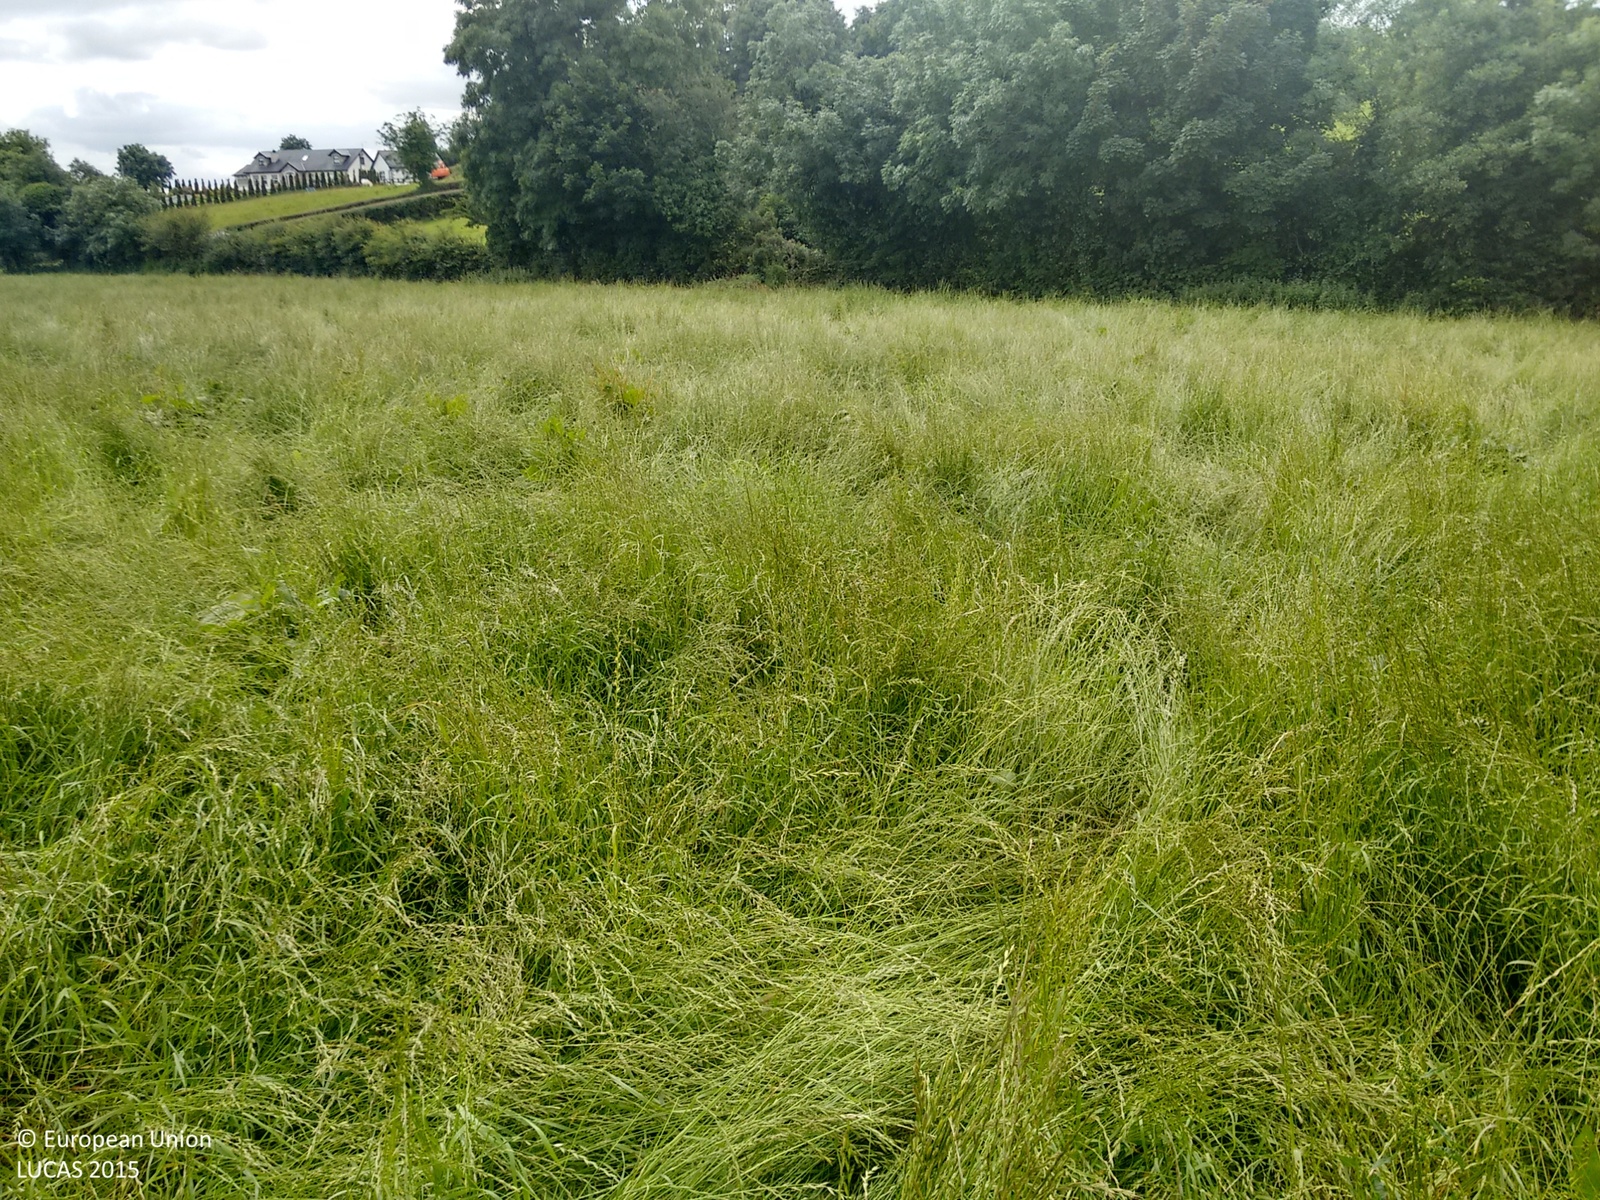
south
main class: Grassland
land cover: Grassland without tree/shrub cover
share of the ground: > 75 %
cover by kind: herbaceous plants 100 %
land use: Agriculture (excluding fallow land and kitchen gardens)
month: August
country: GB
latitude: 54.0585
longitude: -6.6443
